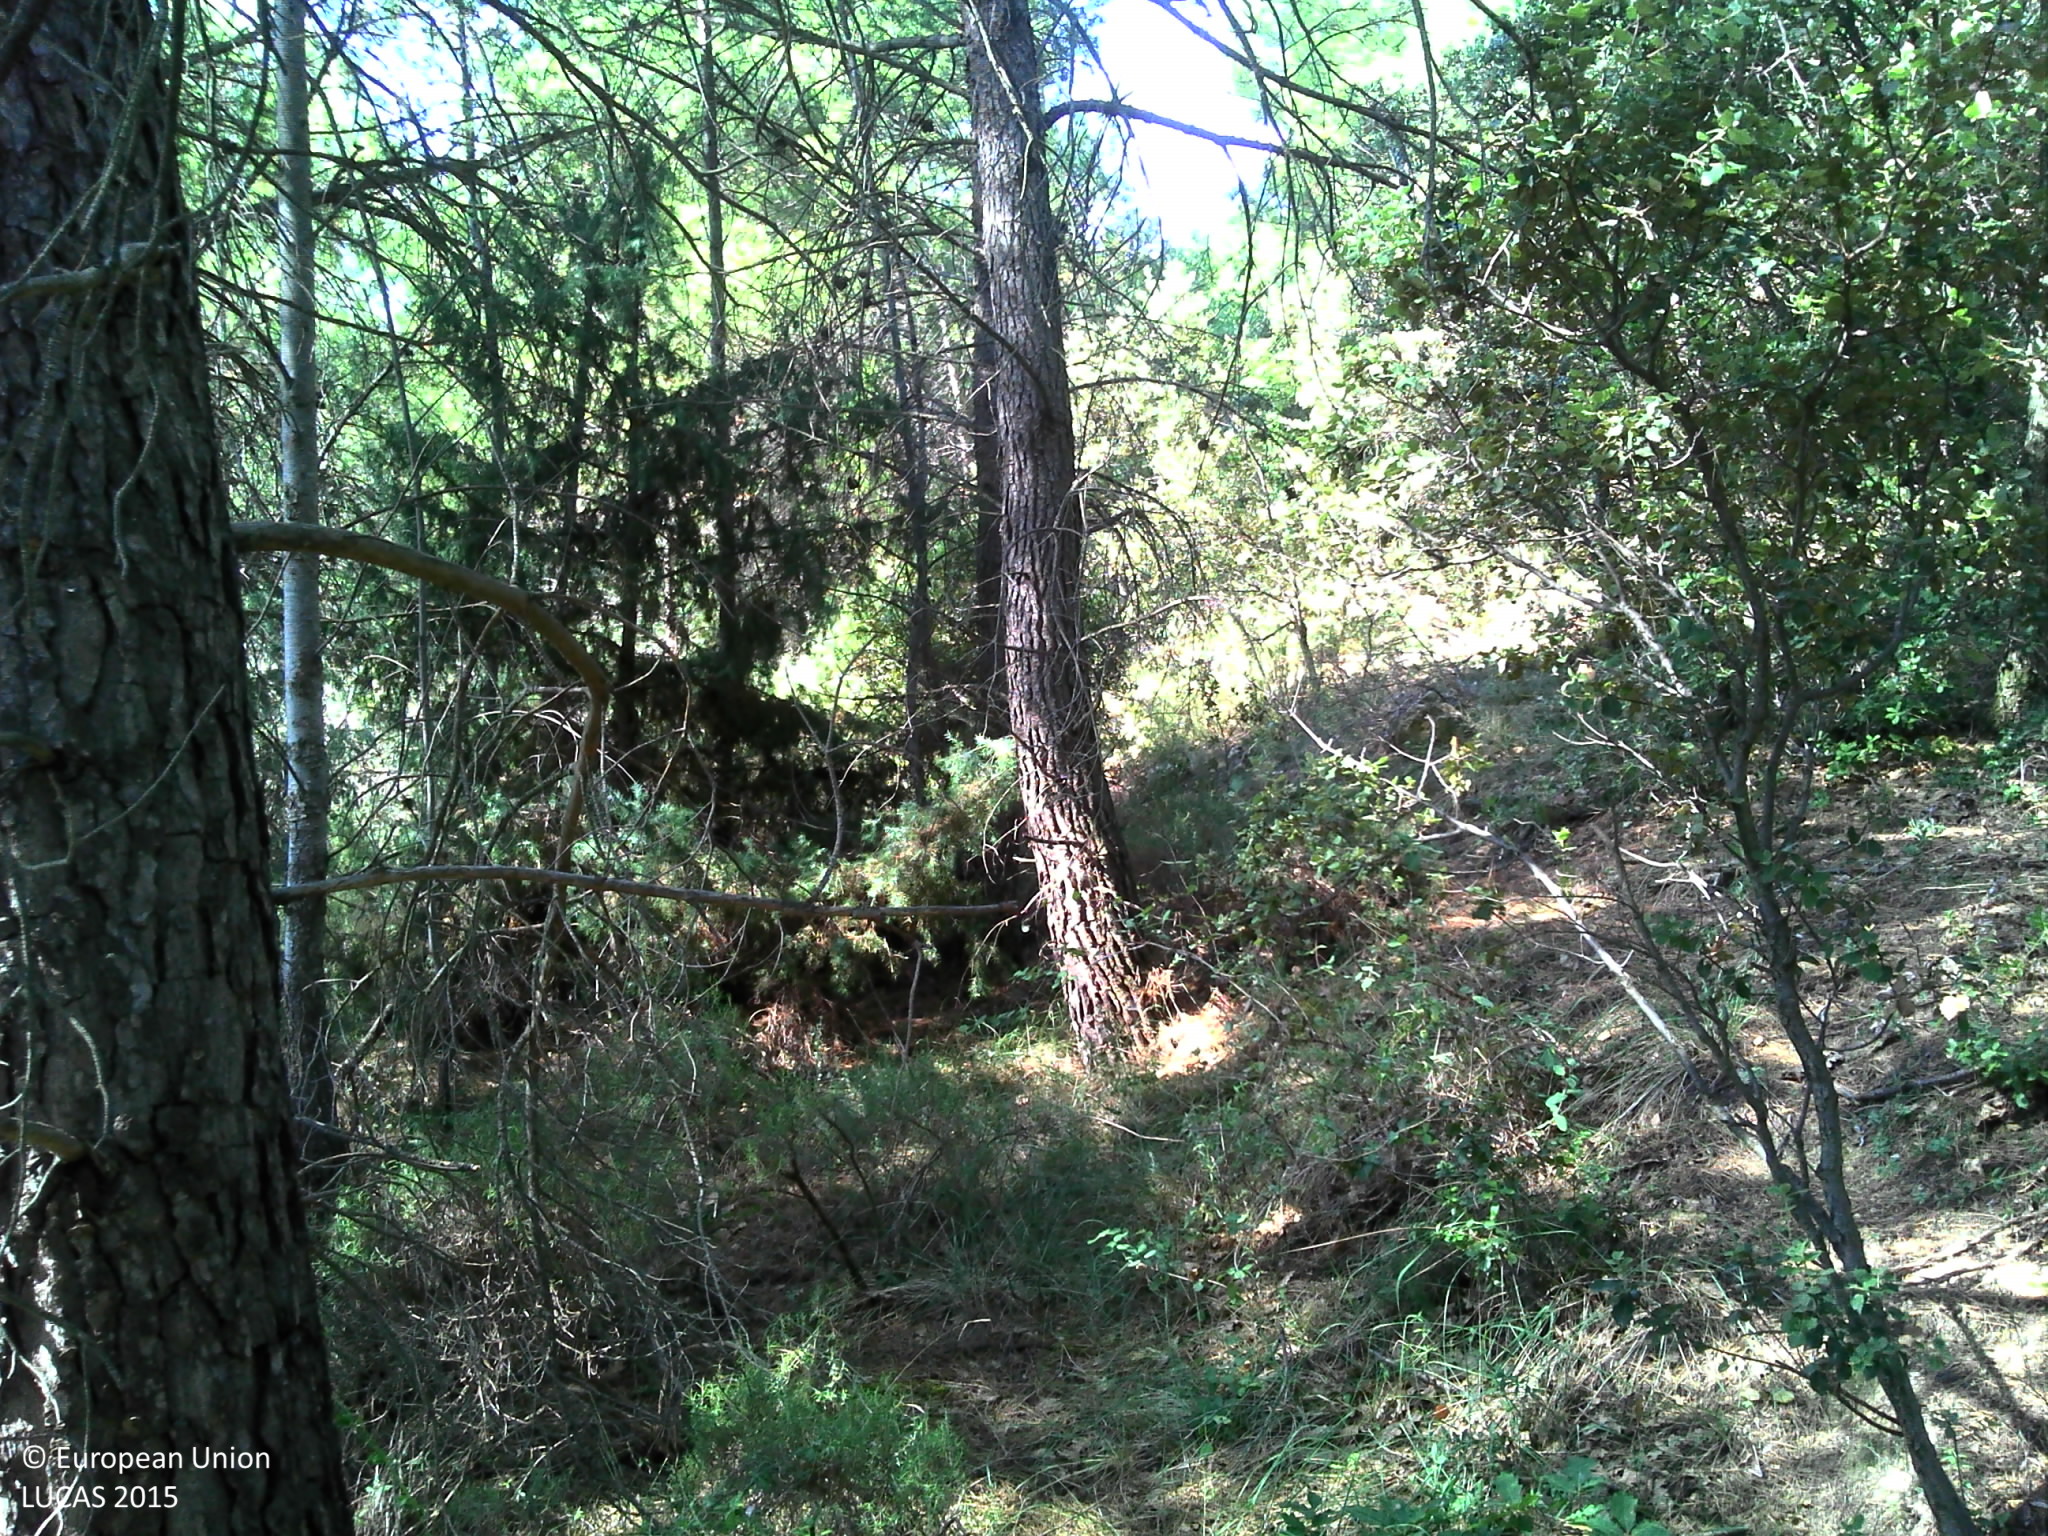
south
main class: Woodland
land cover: Pine dominated mixed woodland
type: mesophytic deciduous forest
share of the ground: > 75 %
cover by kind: coniferous forest trees 40 %, broadleaved forest trees 30 %, shrubs 10 %, herbaceous plants 10 %, lichens and mosses 10 %
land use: Semi-natural and natural areas not in use
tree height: > 5 m
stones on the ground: < 10 %
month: July
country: FR
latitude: 44.1611
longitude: 5.0686
